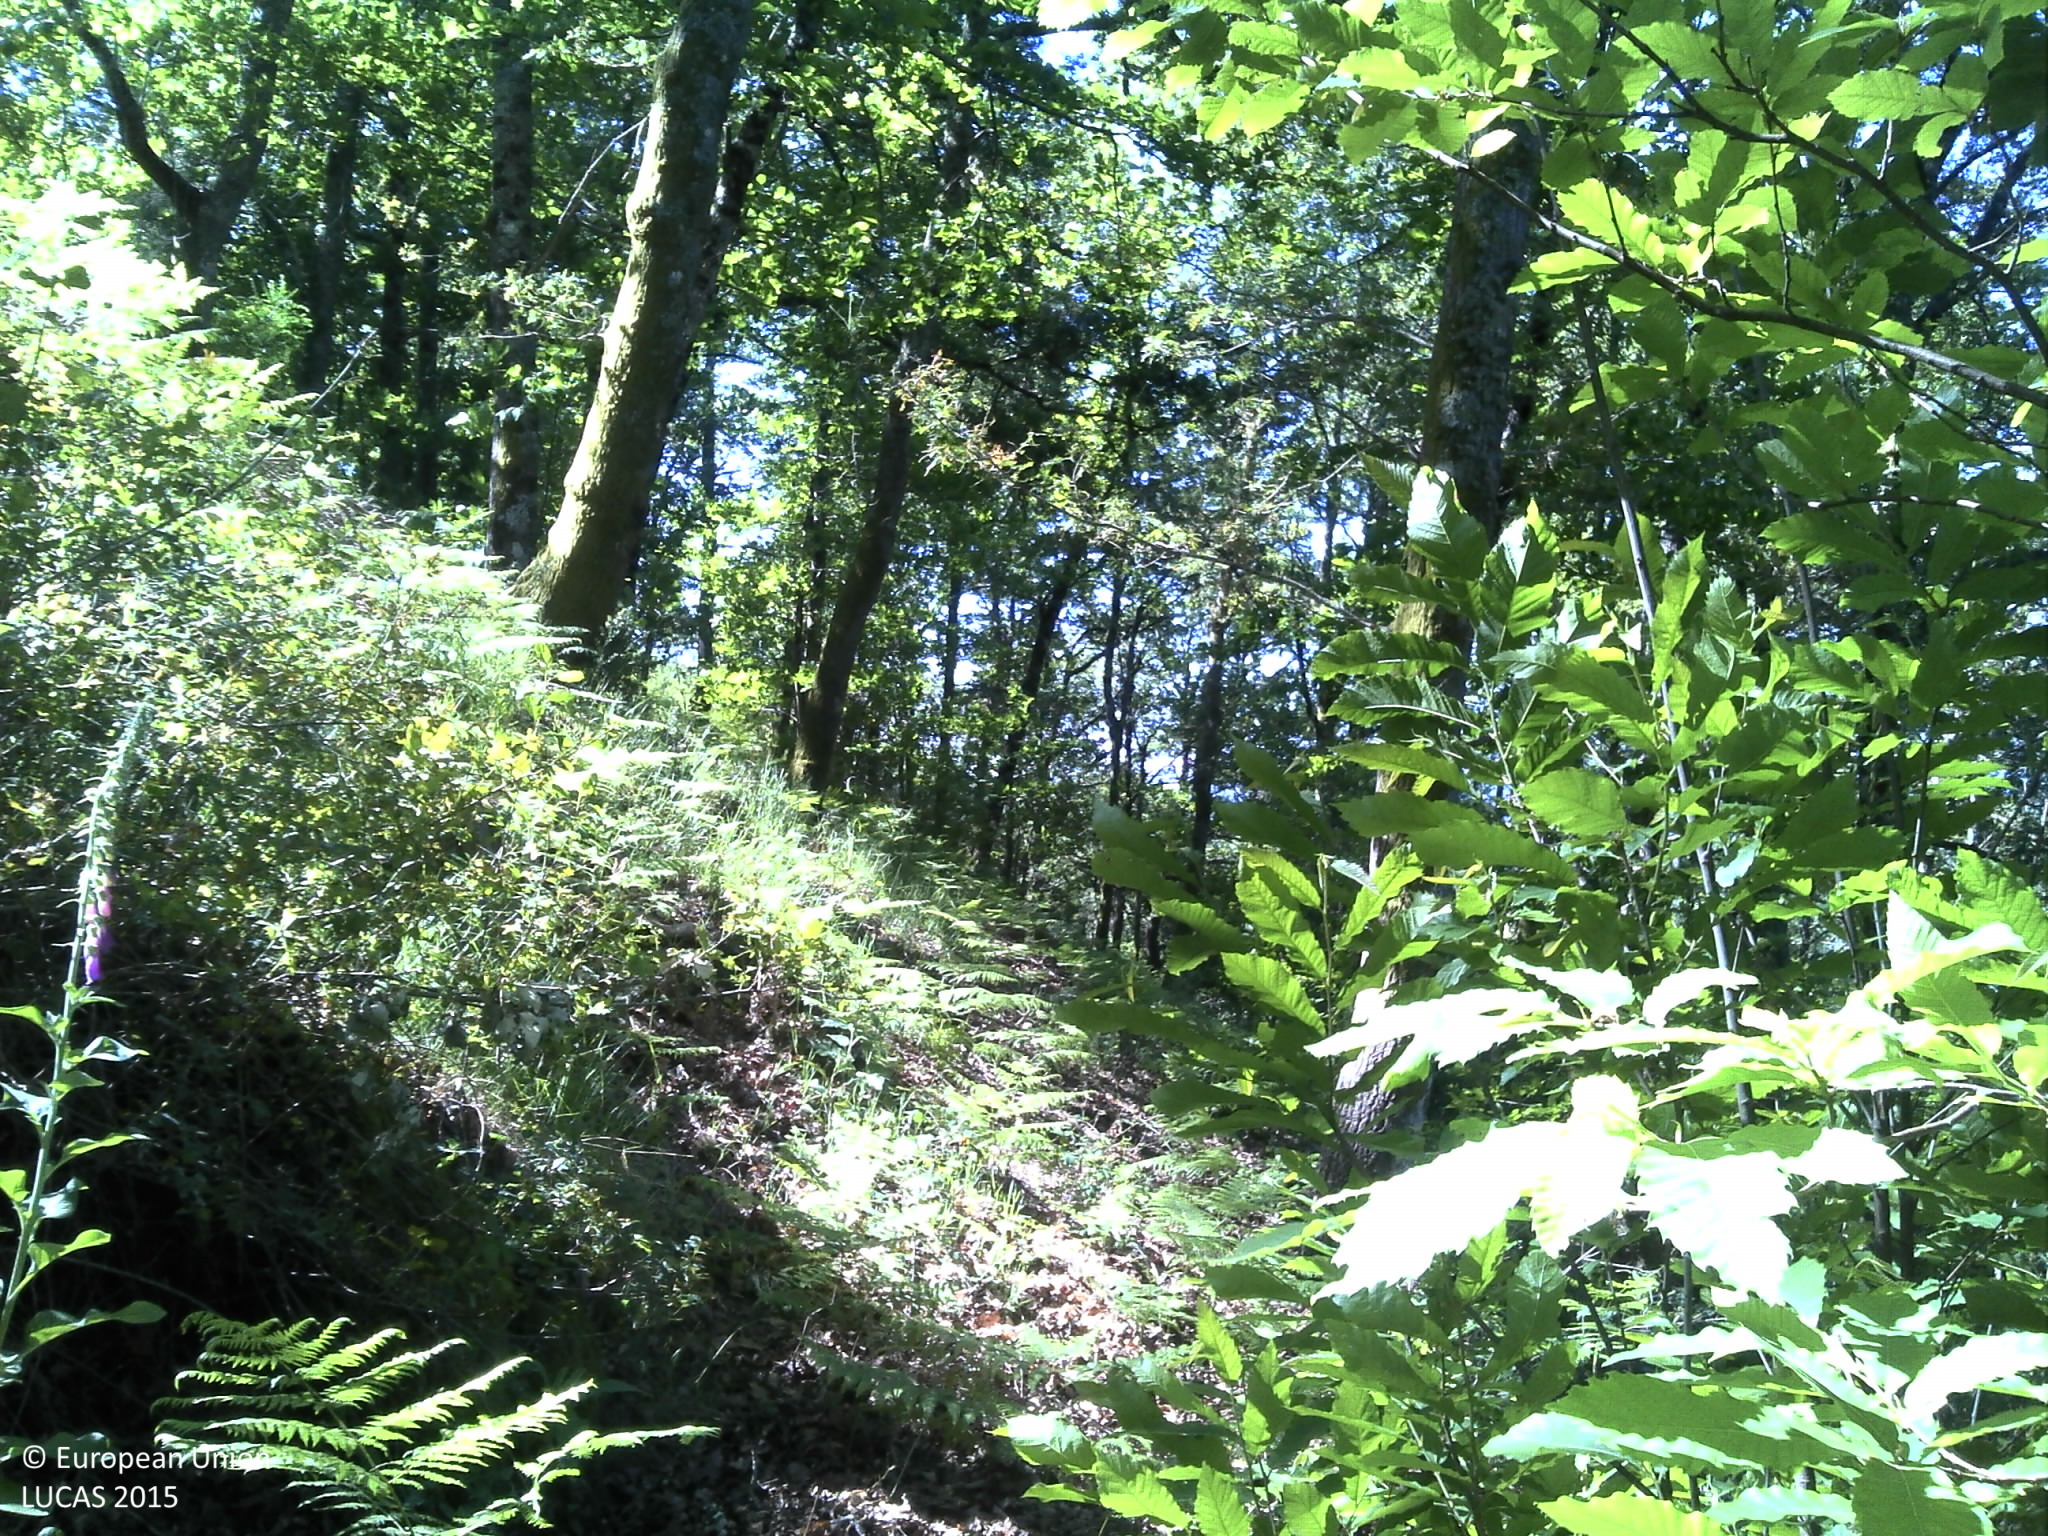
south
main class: Woodland
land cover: Broadleaved woodland
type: thermophilous deciduous forest
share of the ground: 50 - 75 %
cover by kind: broadleaved forest trees 75 %, shrubs 10 %, unconsolidated bare surface 10 %, herbaceous plants 5 %
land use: Forestry
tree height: > 5 m
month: May
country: PT
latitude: 40.9408
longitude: -7.9591
